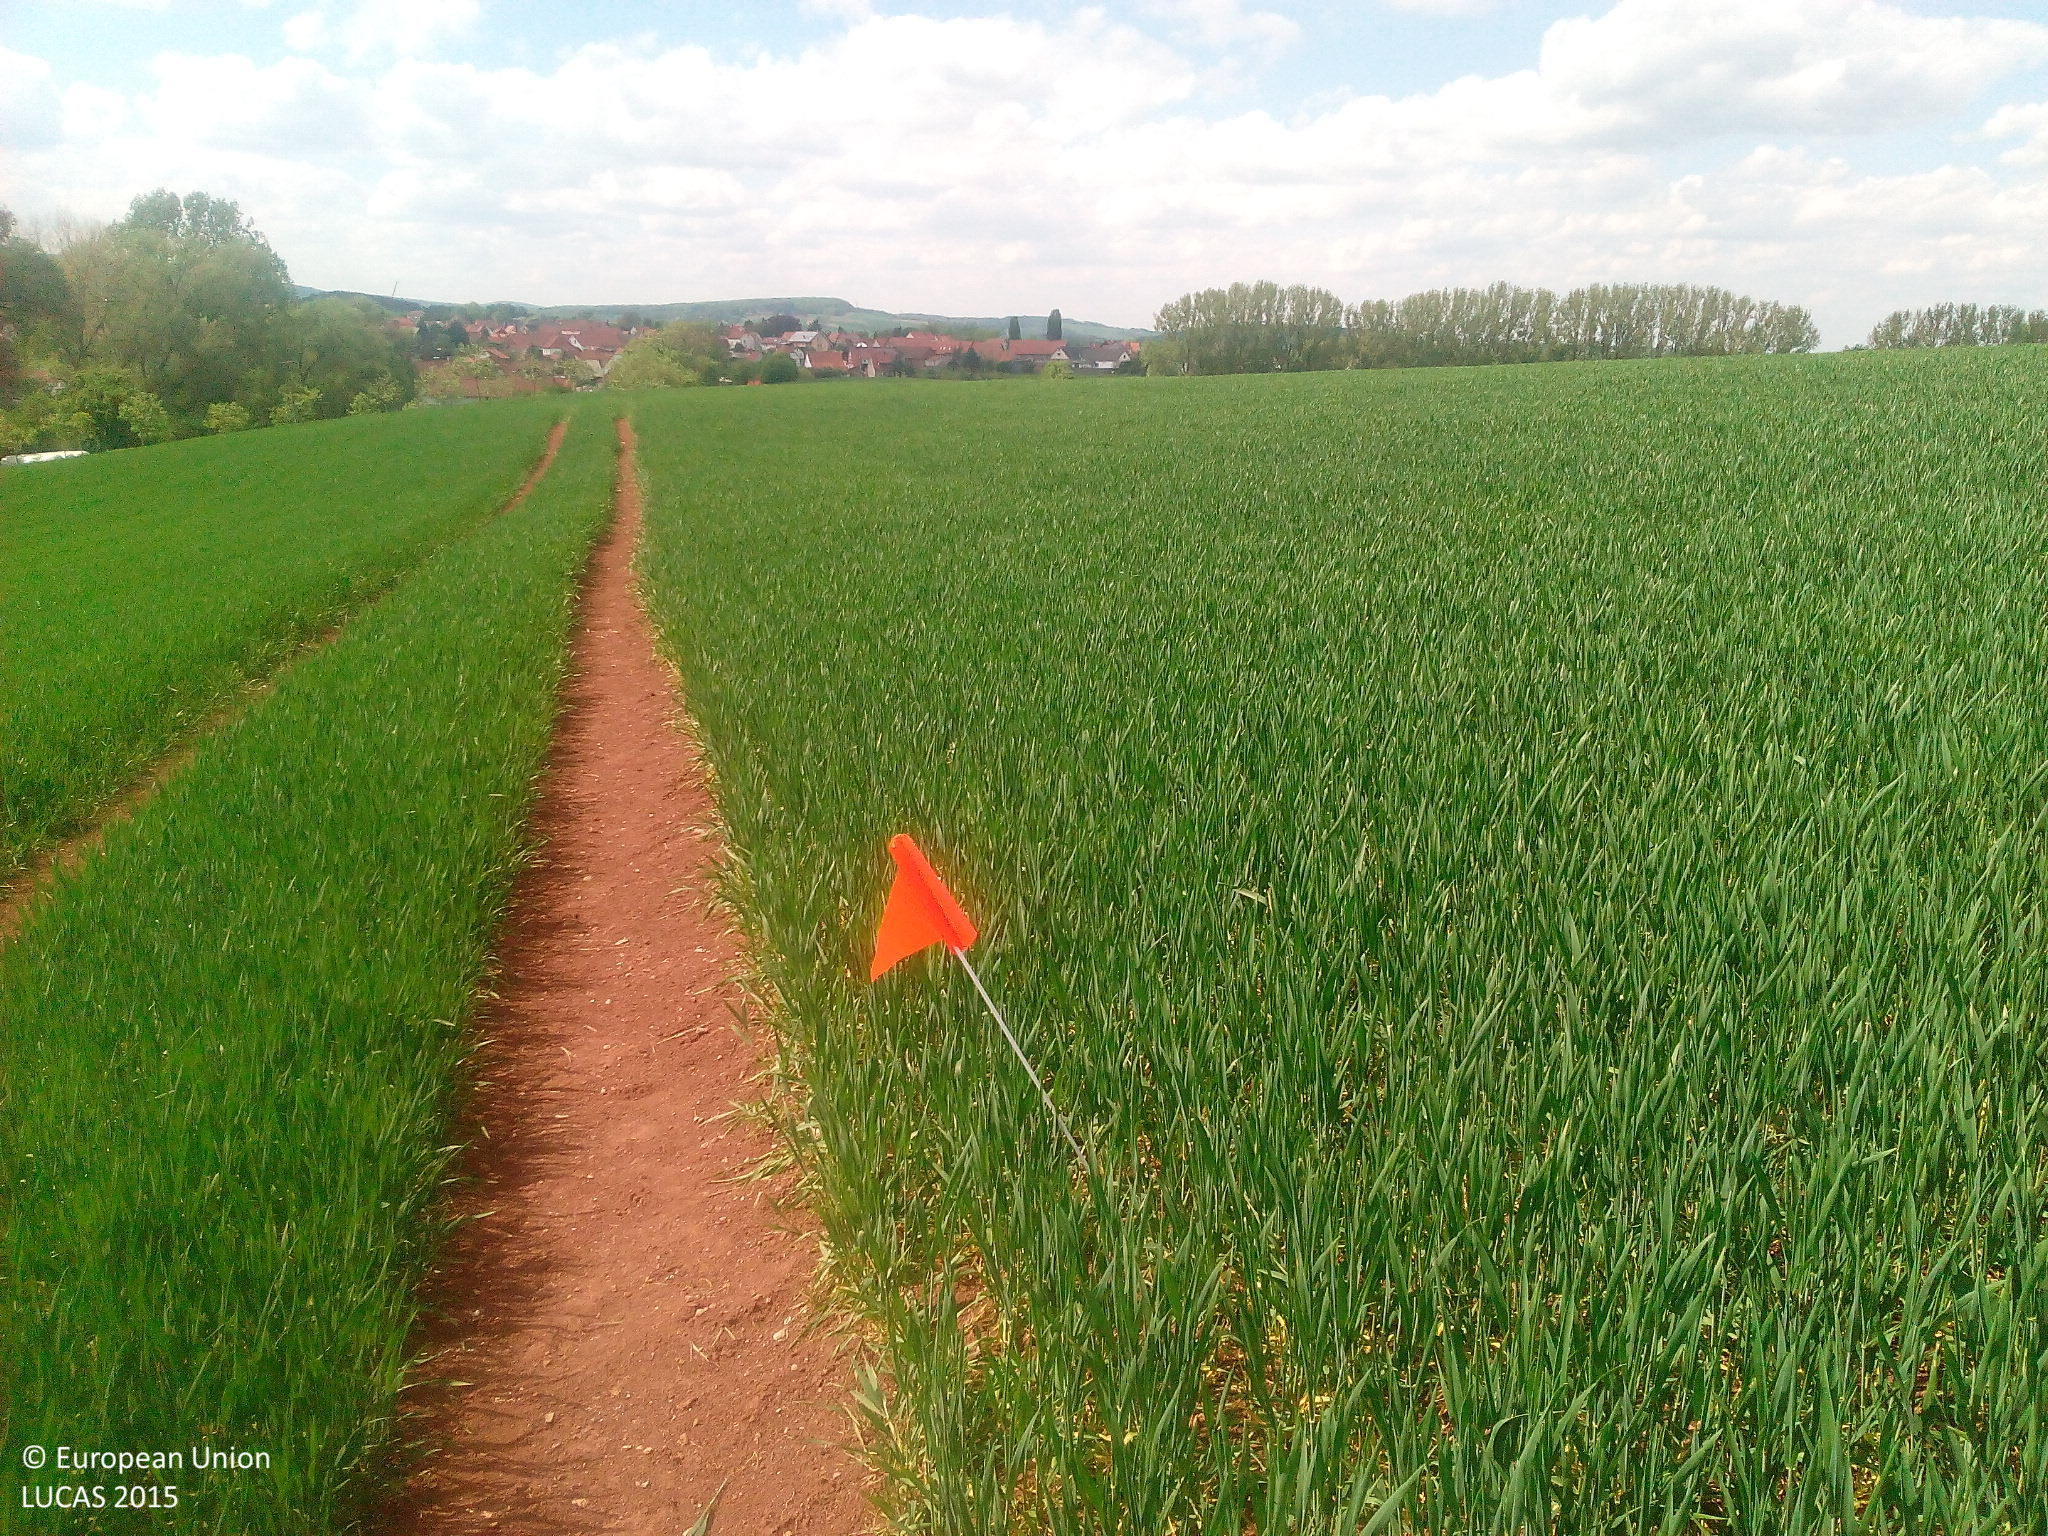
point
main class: Cropland
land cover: Triticale
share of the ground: > 75 %
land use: Agriculture (excluding fallow land and kitchen gardens)
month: May
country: DE
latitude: 51.3708
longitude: 9.9569
